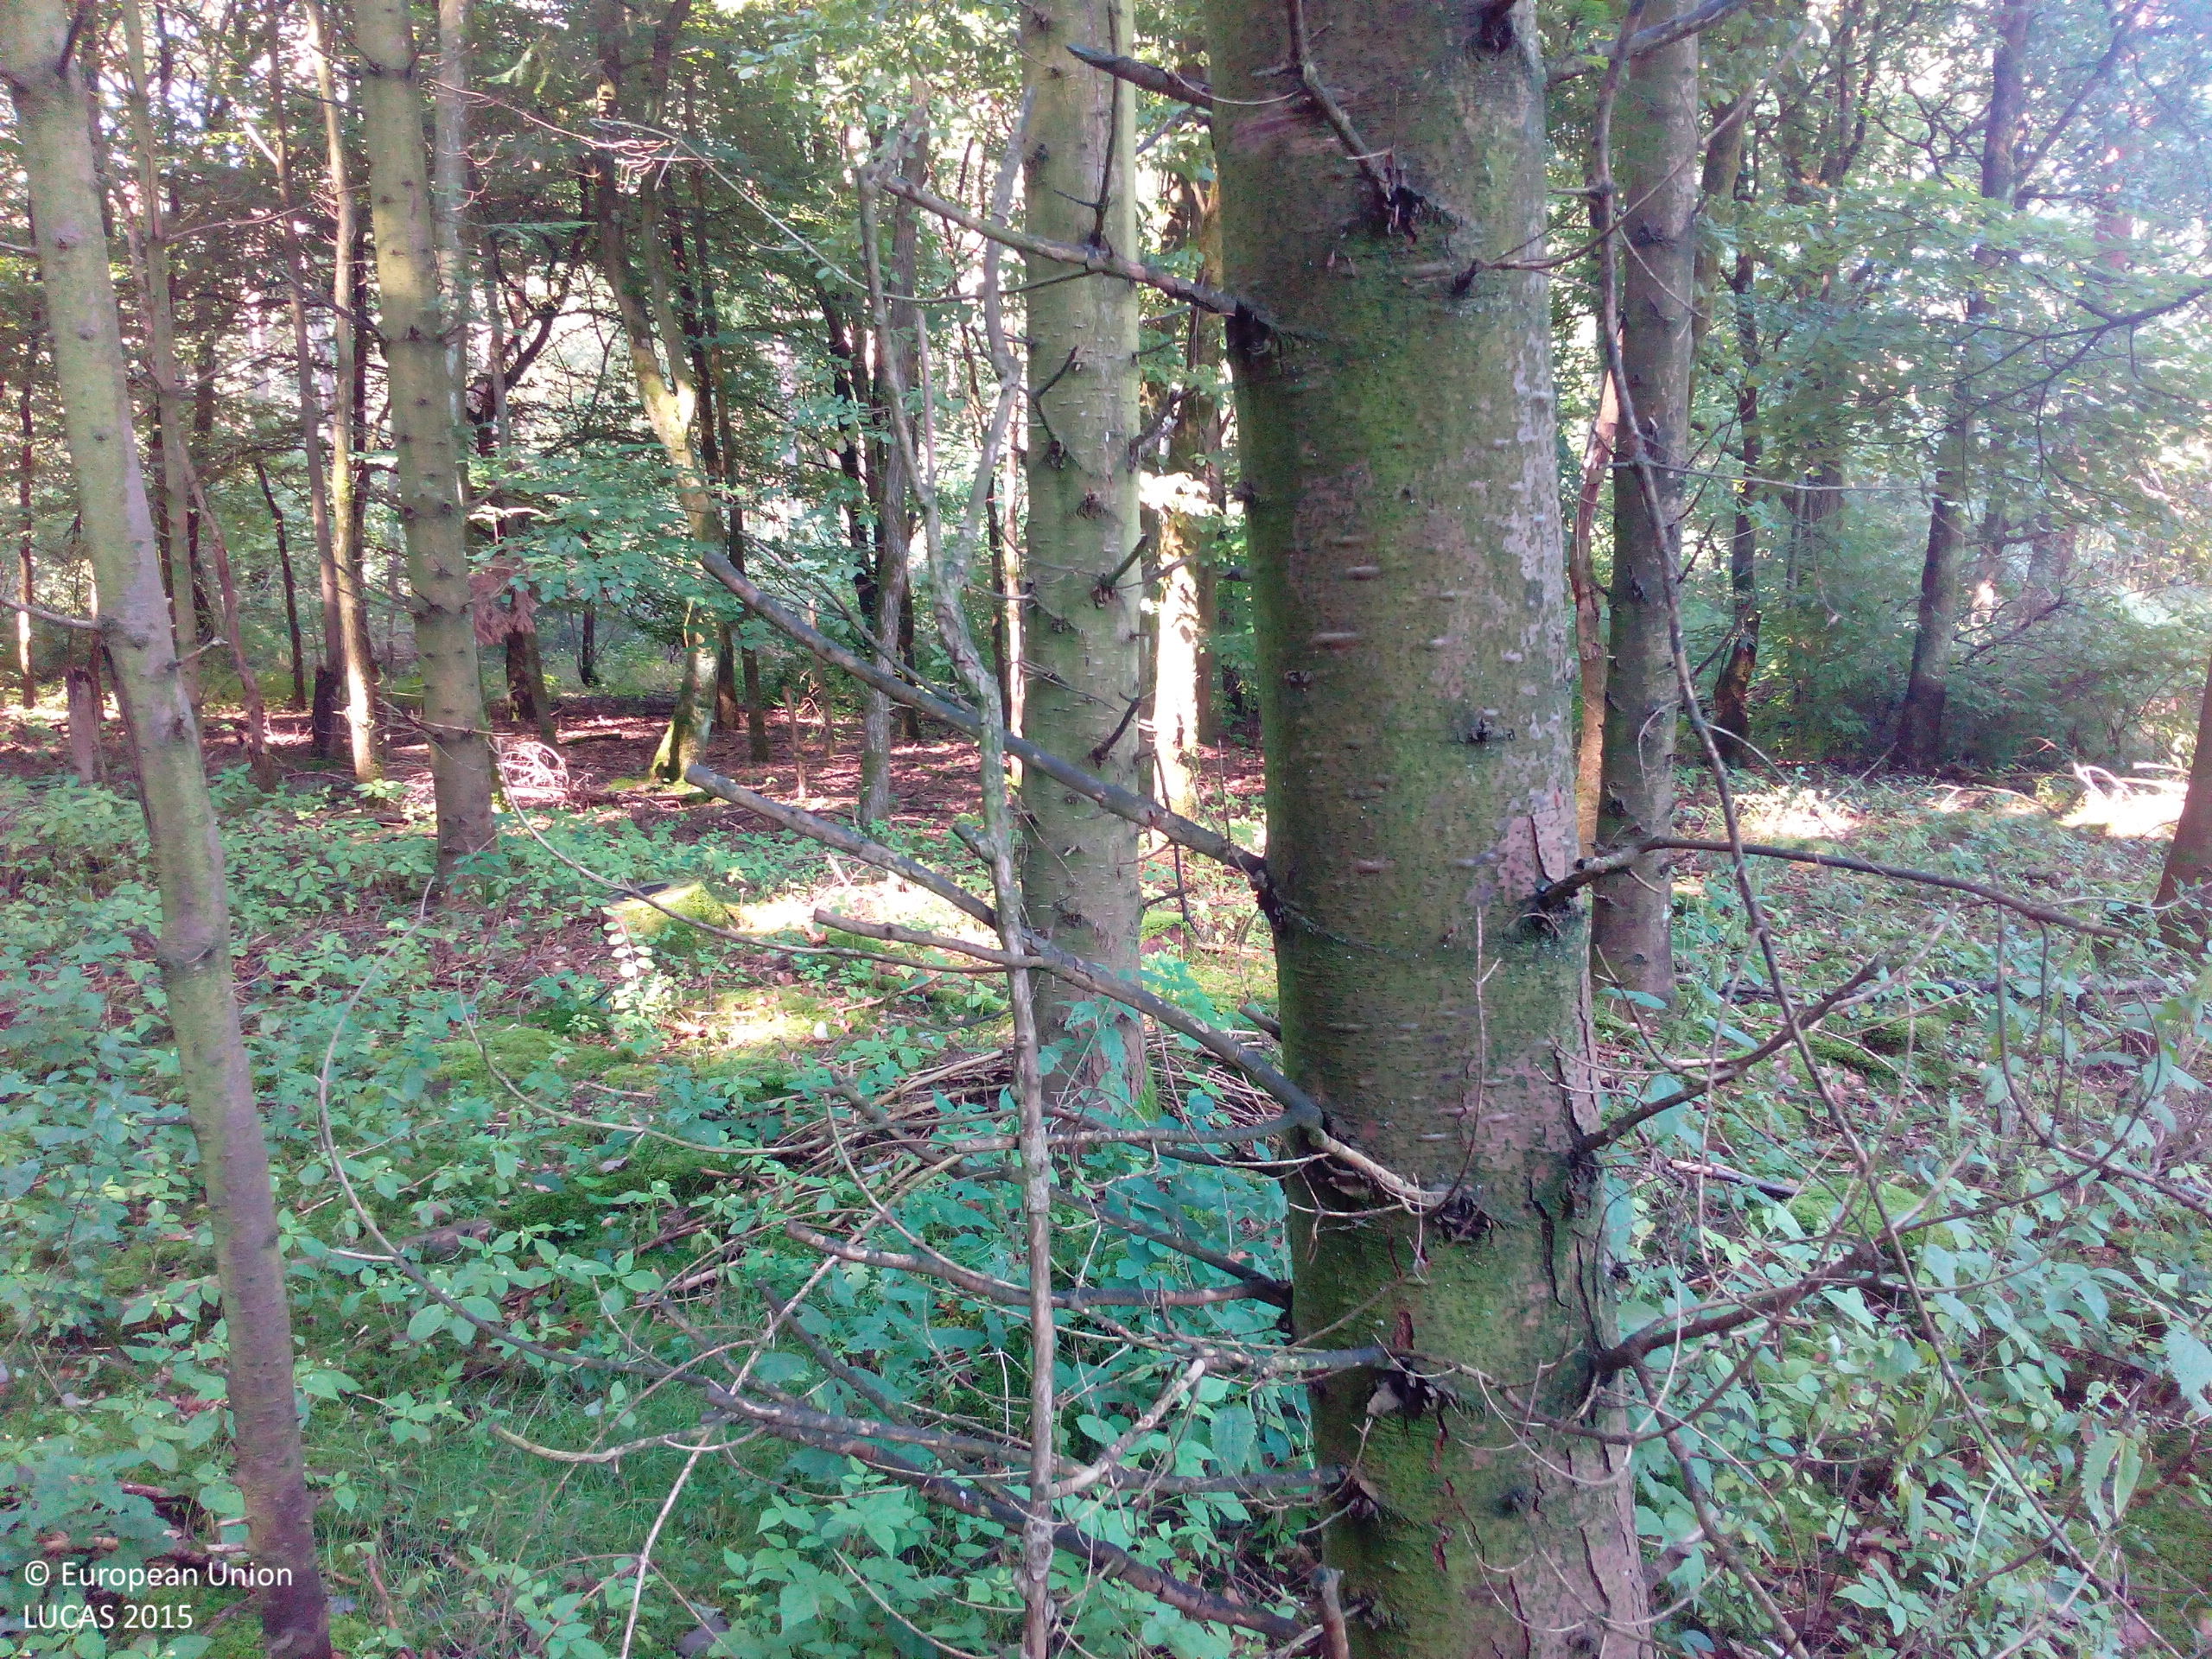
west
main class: Woodland
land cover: Other mixed woodland
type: hemiboreal forest and nemoral coniferous forest and mixed broadleaved-coniferous forest
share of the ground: > 75 %
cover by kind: coniferous forest trees 75 %, broadleaved forest trees 25 %
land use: Forestry
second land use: Amenities, museums, leisure
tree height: > 5 m
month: August
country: DE
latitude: 53.8152
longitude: 9.8330
